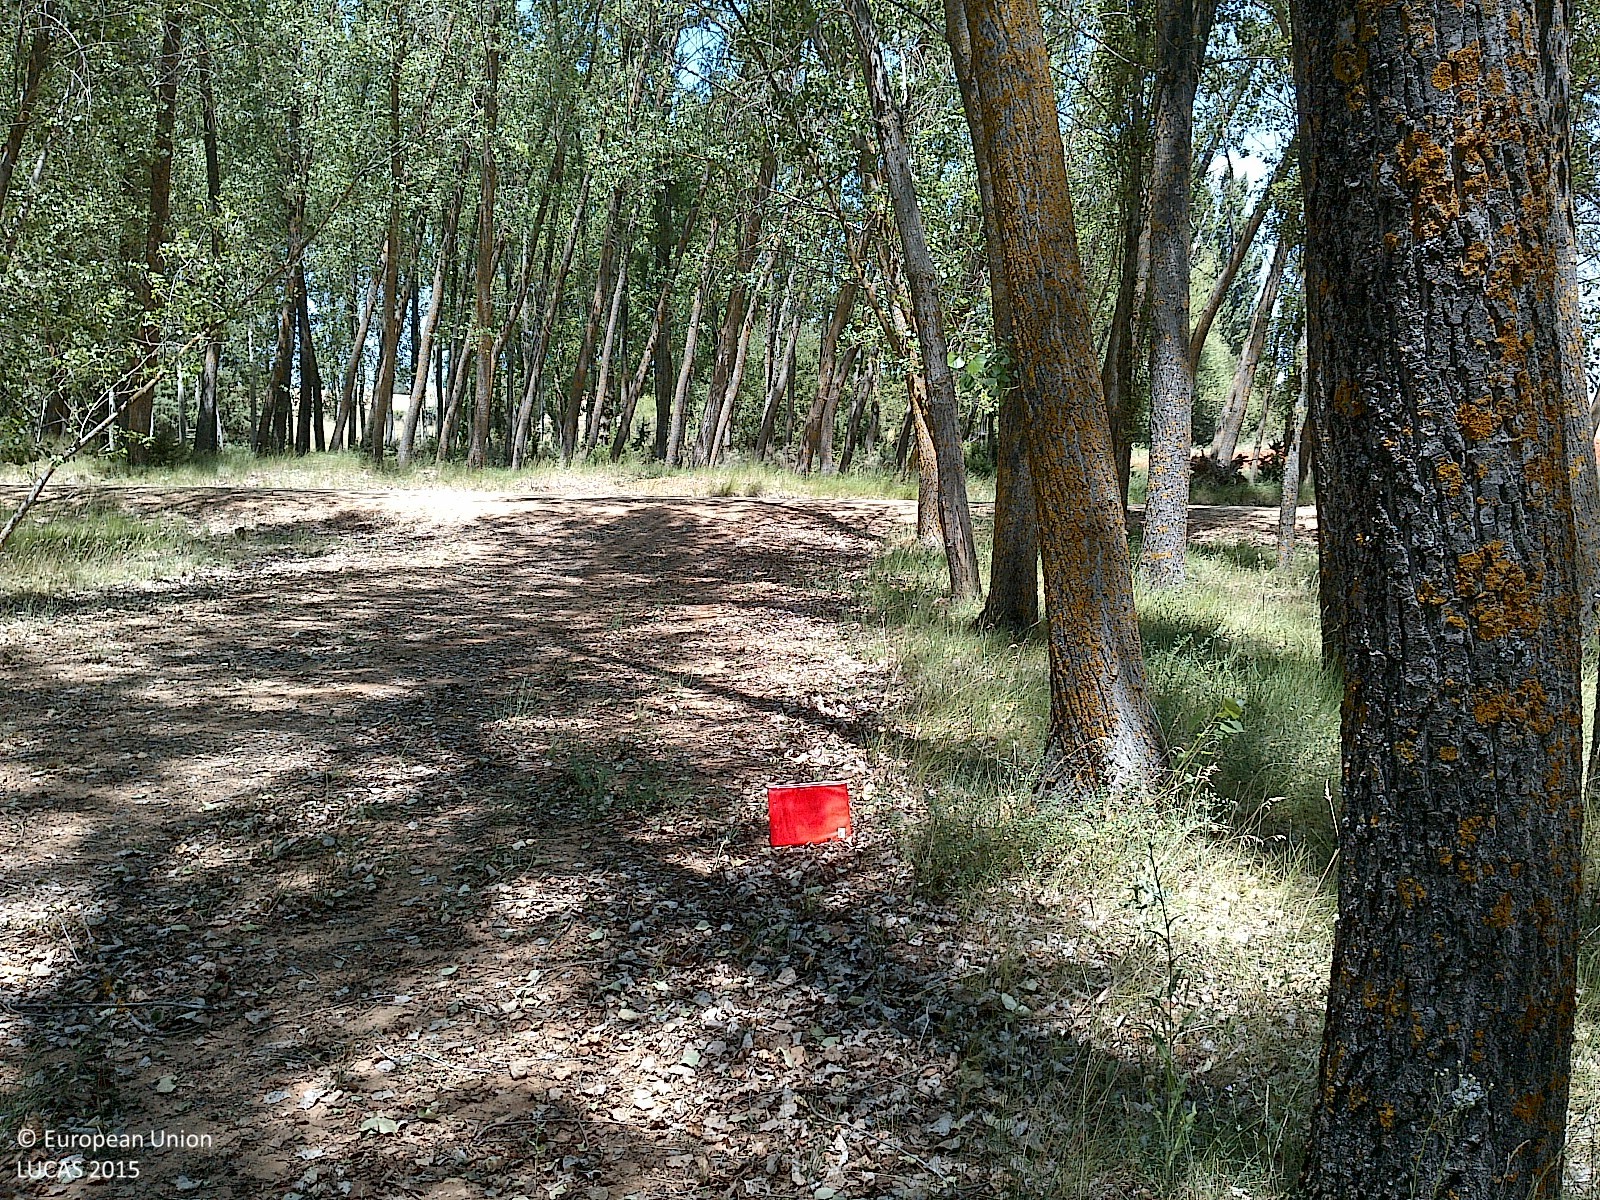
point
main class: Woodland
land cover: Broadleaved woodland
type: exotic forest
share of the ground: > 75 %
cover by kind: broadleaved forest trees 85 %, unconsolidated bare surface 10 %, herbaceous plants 5 %
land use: Forestry
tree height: > 5 m
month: July
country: ES
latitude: 41.7620
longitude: -3.2424
